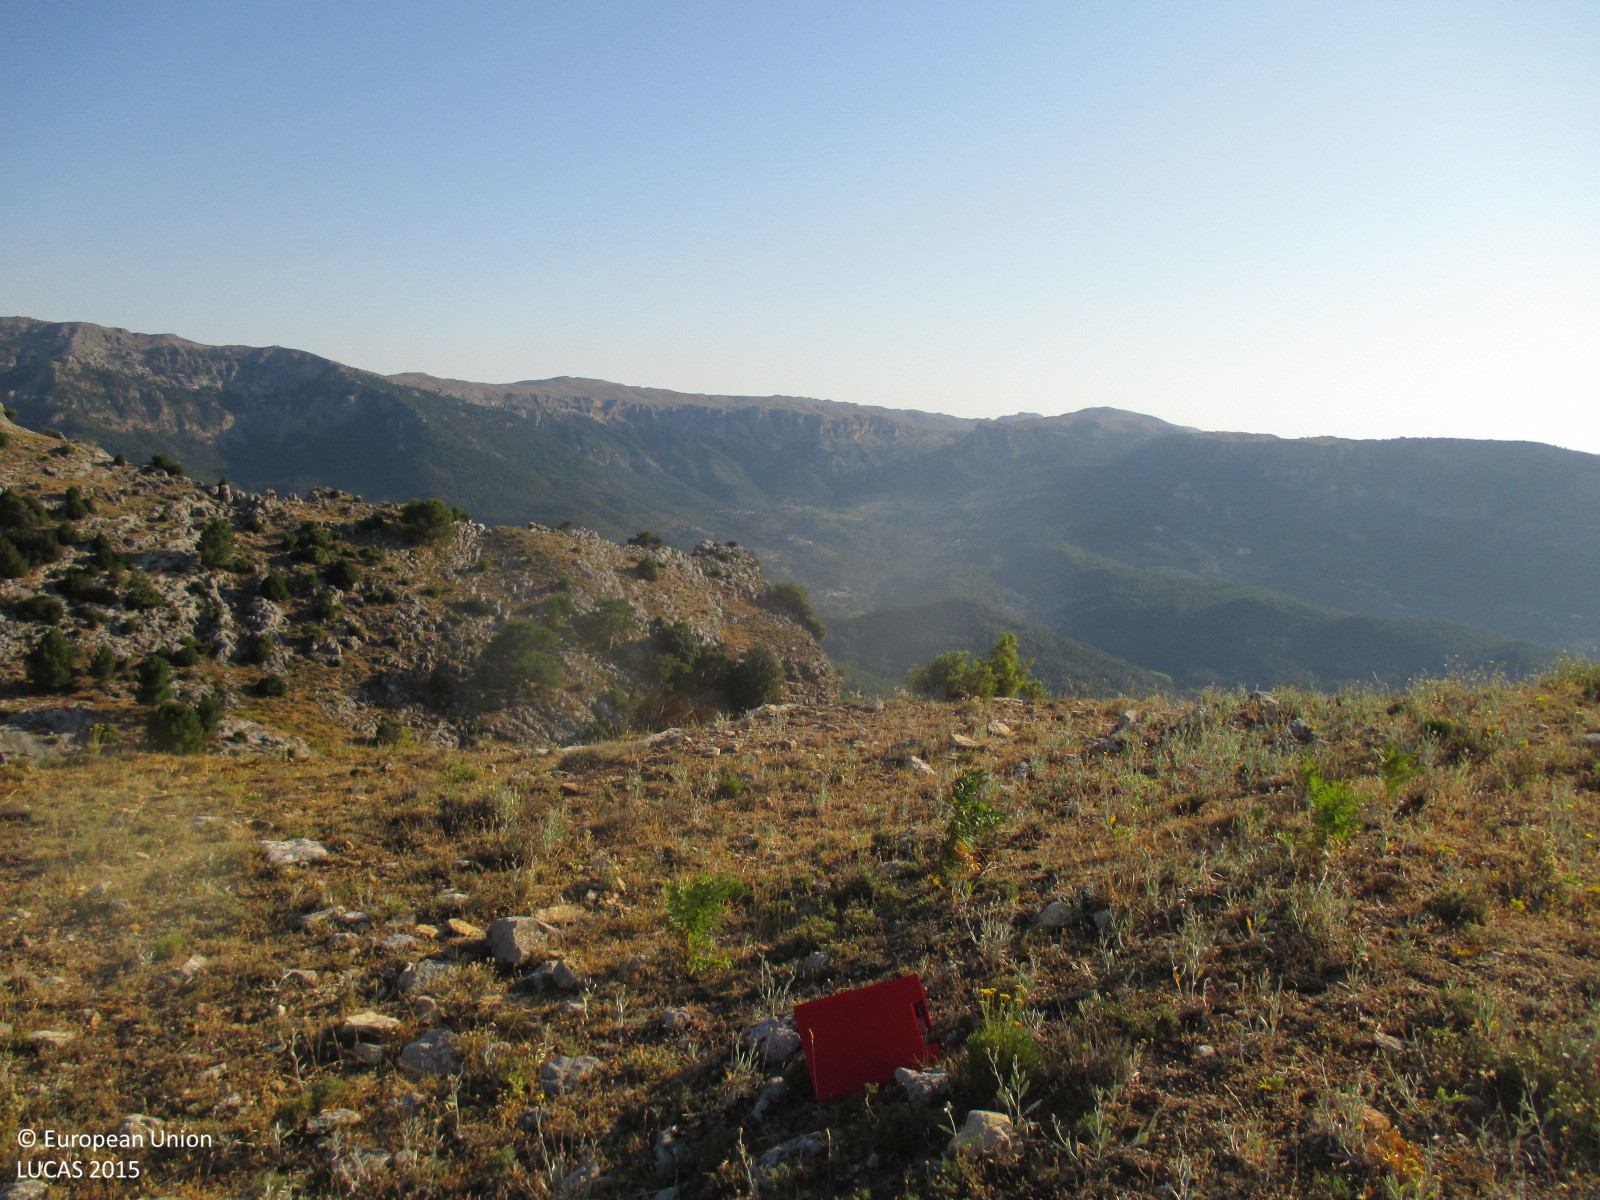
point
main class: Grassland
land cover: Grassland without tree/shrub cover
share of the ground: > 75 %
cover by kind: herbaceous plants 90 %, consolidated bare surface 10 %
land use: Semi-natural and natural areas not in use
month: July
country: ES
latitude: 38.3537
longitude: -2.4584
